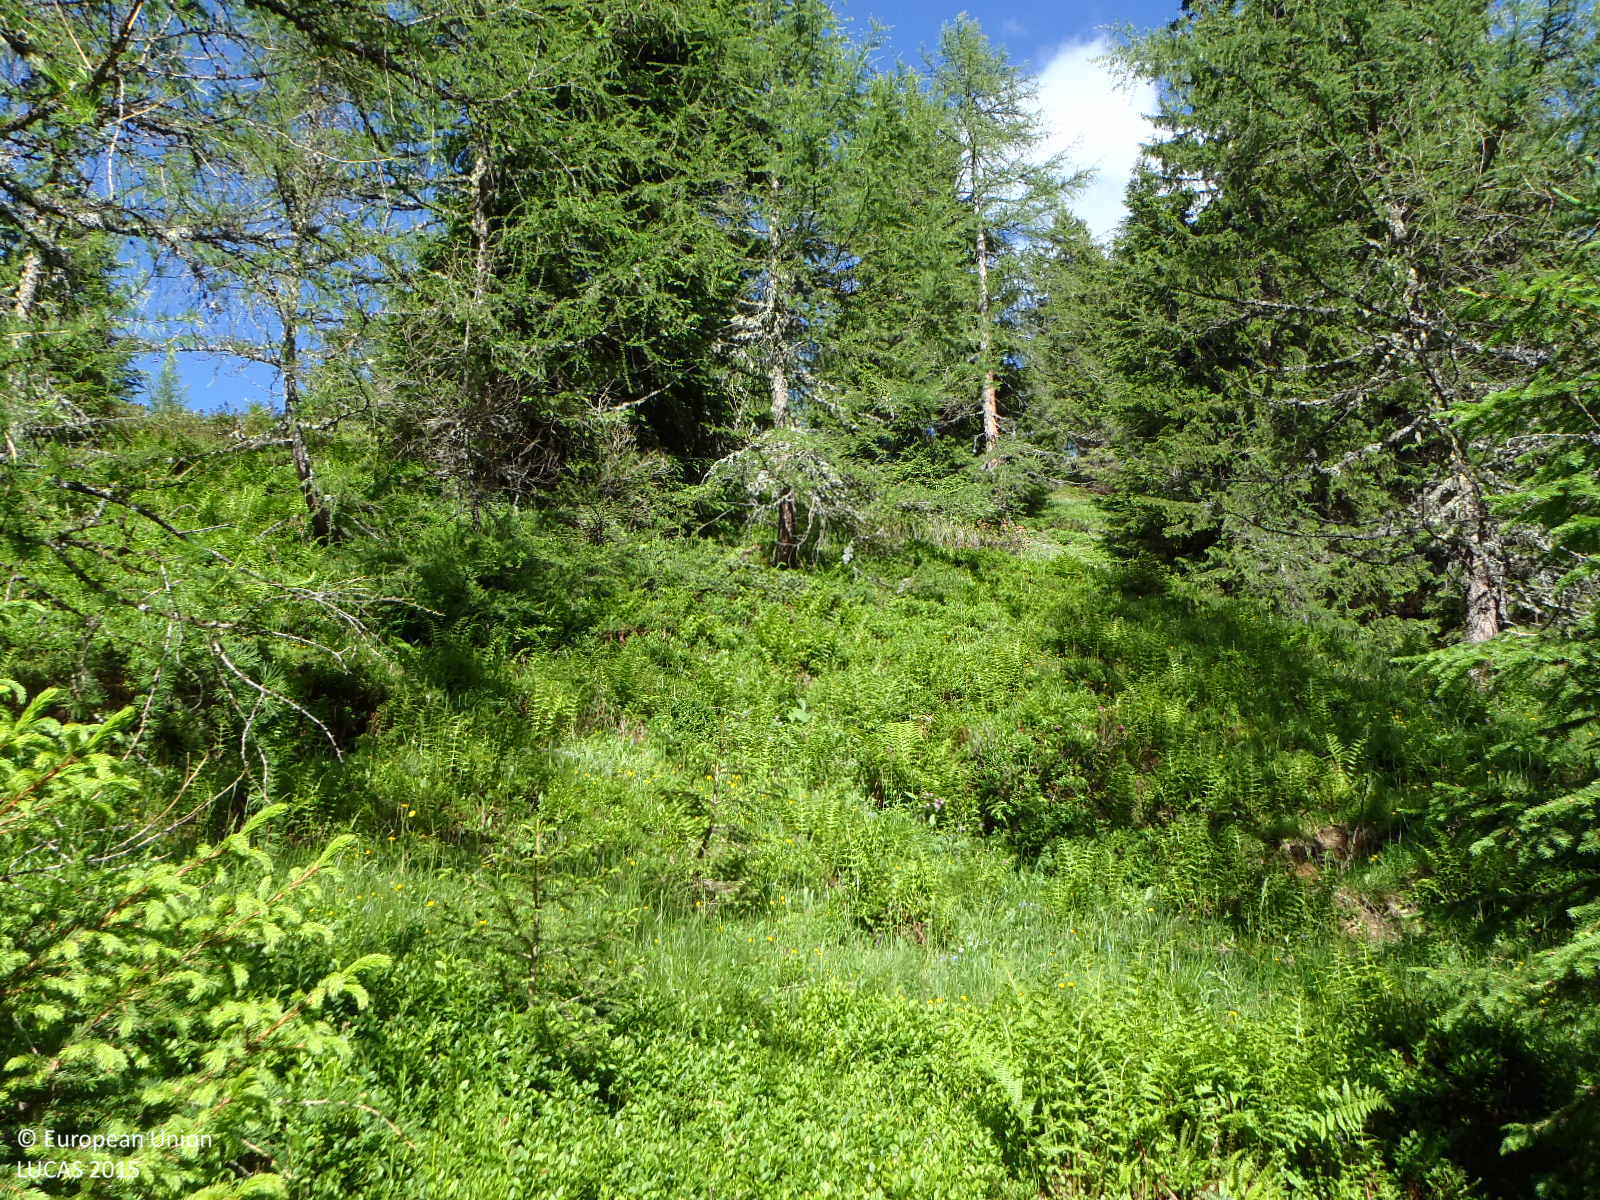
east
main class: Woodland
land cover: Other coniferous woodland
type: alpine coniferous forest
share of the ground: 50 - 75 %
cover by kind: coniferous forest trees 55 %, shrubs 20 %, herbaceous plants 20 %, lichens and mosses 5 %
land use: Forestry
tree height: > 5 m
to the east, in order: Other coniferous woodland; Tracks; Other coniferous woodland; Tracks; Grassland without tree/shrub cover; Tracks; Grassland without tree/shrub cover; Tracks; Grassland without tree/shrub cover; Fences; Tracks; Grassland without tree/shrub cover; Fences; Tracks
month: June
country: AT
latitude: 47.3464
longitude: 12.6058
